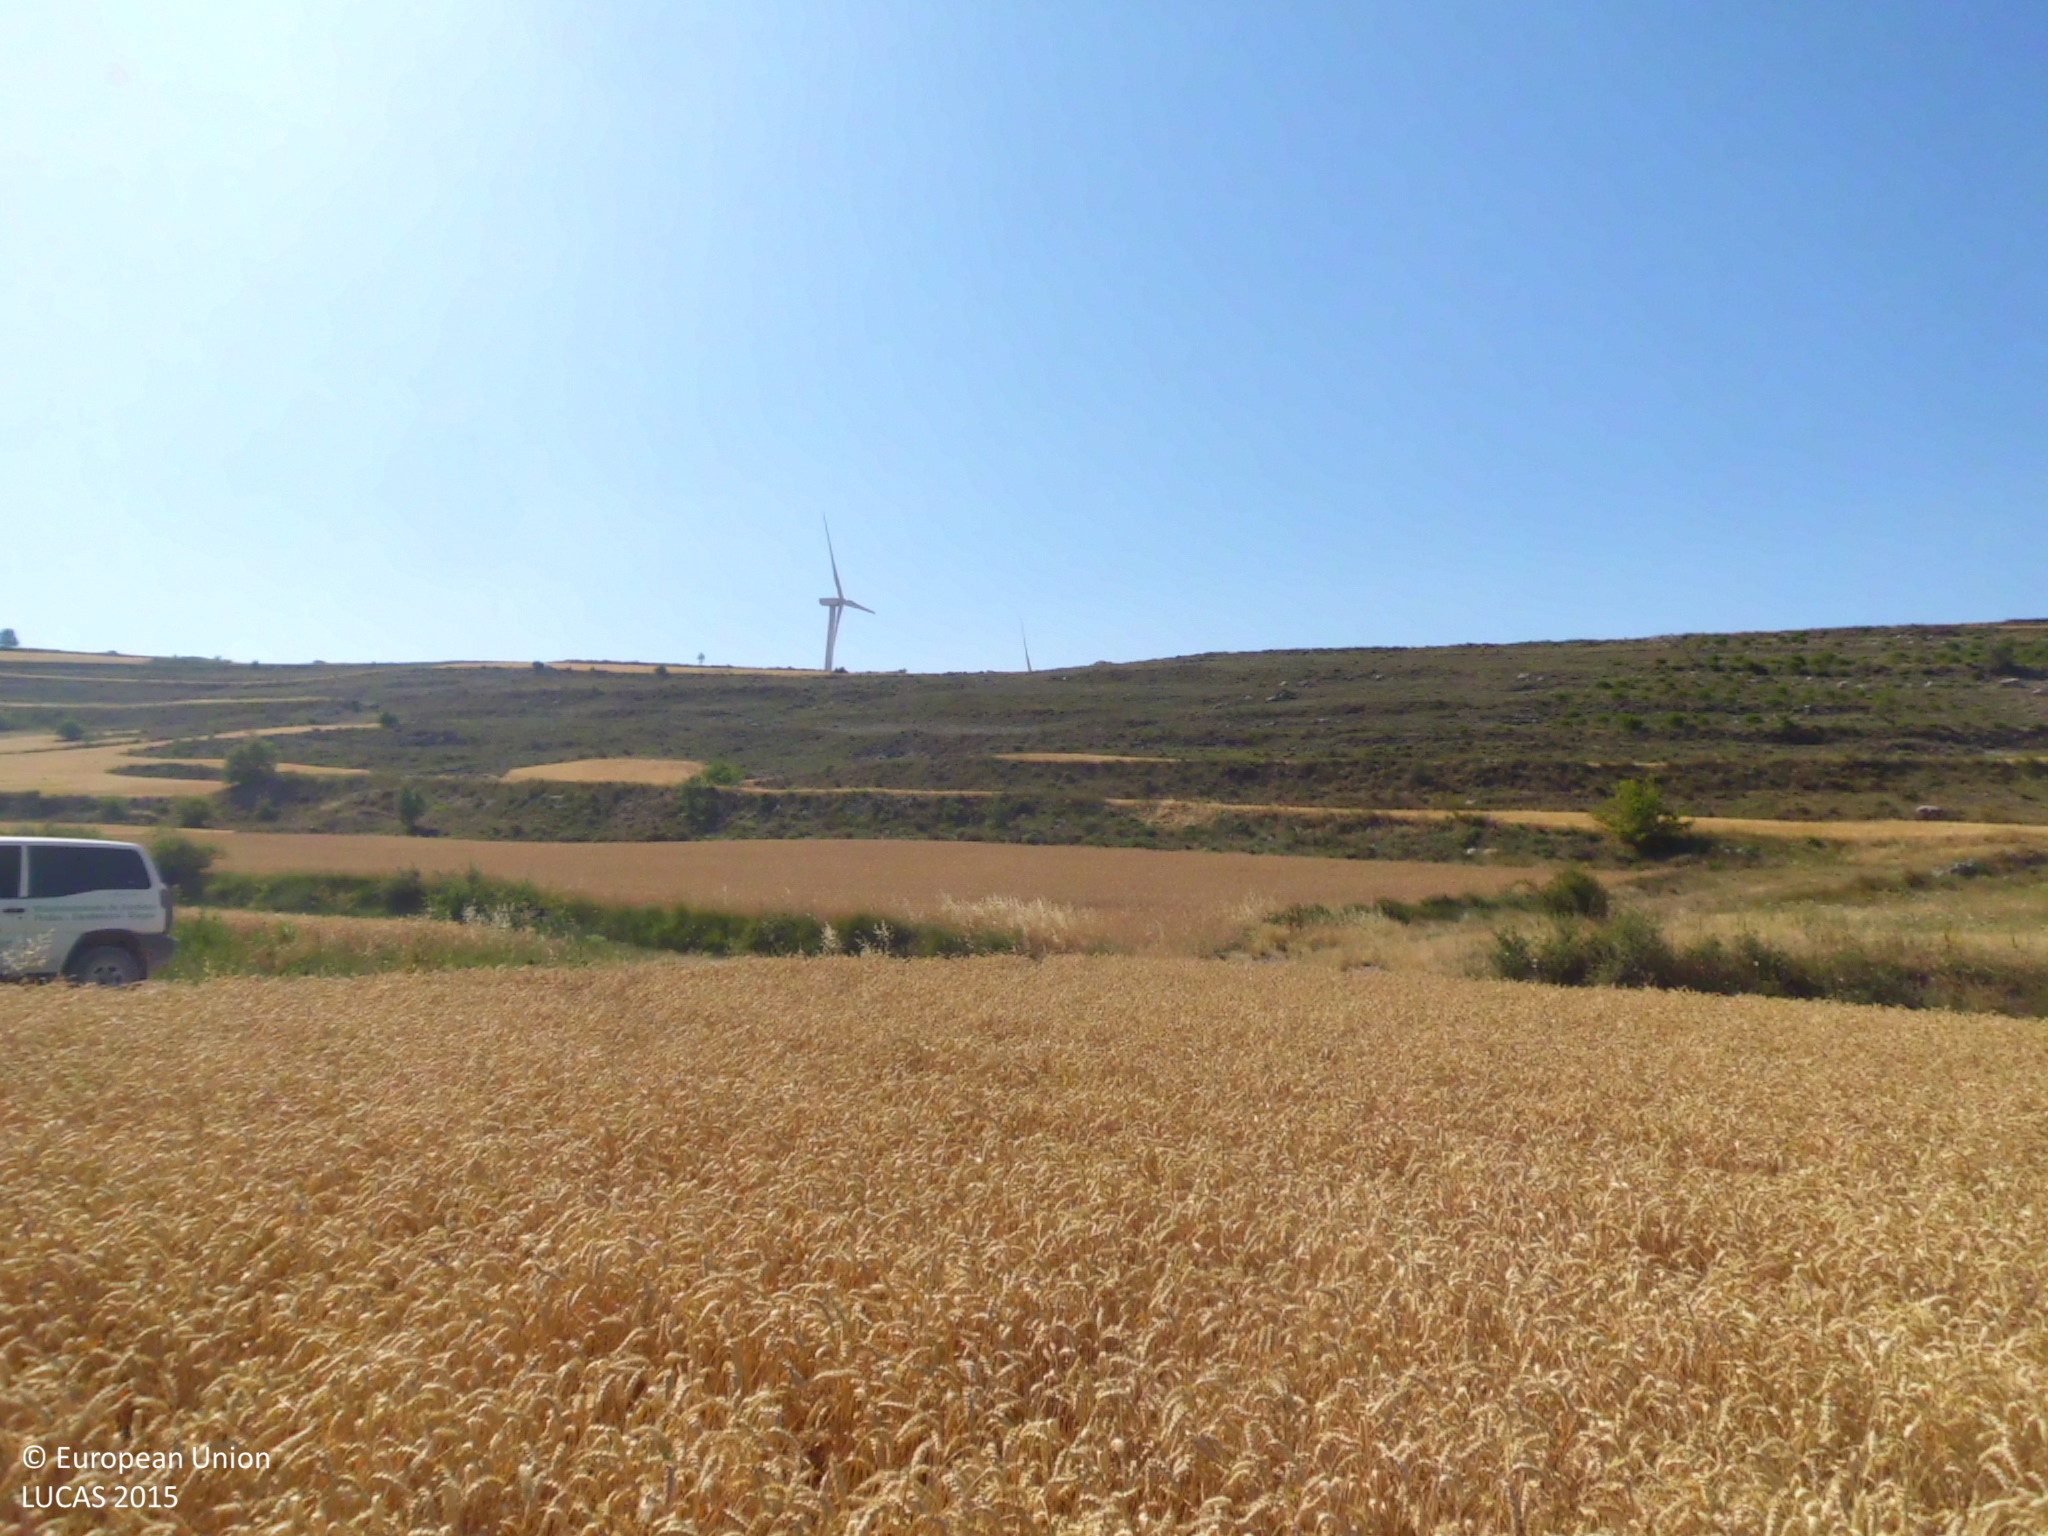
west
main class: Cropland
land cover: Common wheat
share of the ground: > 75 %
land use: Agriculture (excluding fallow land and kitchen gardens)
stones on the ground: 10 - 25 %
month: July
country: ES
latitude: 42.4245
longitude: -3.8833
